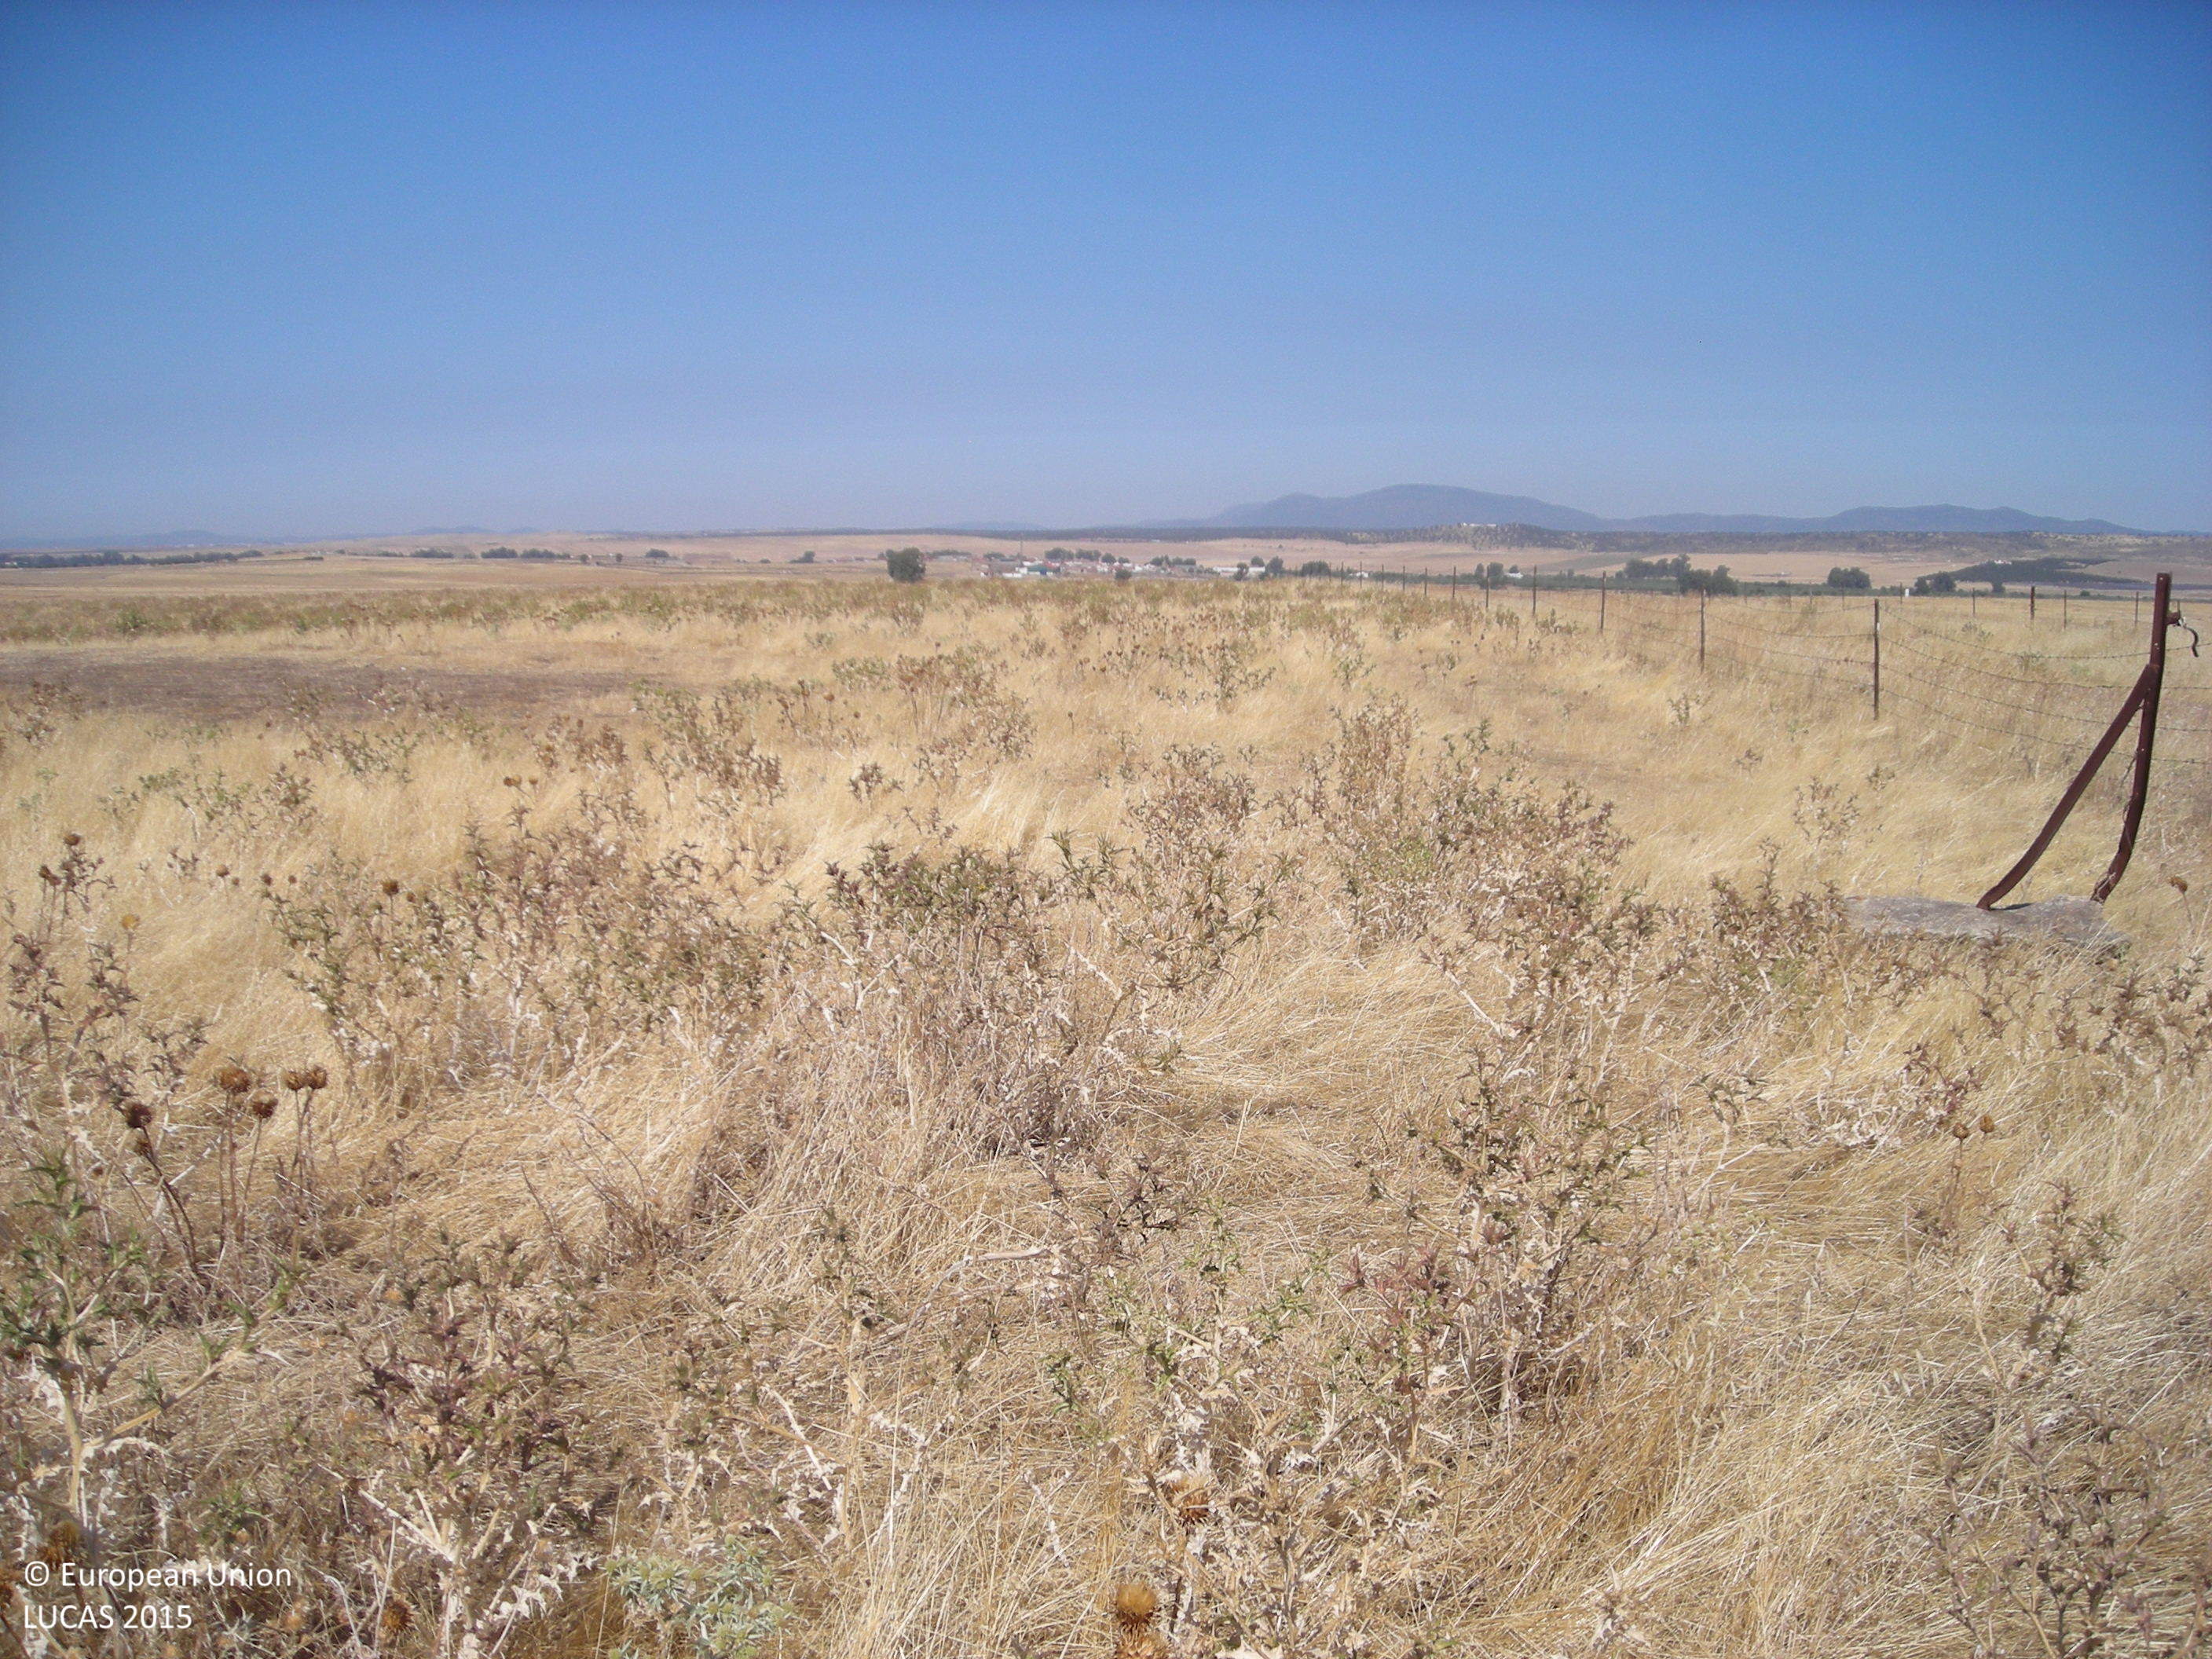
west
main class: Grassland
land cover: Grassland without tree/shrub cover
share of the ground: > 75 %
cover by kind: herbaceous plants 100 %
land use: Agriculture (excluding fallow land and kitchen gardens)
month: July
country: ES
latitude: 39.1904
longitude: -5.7390
